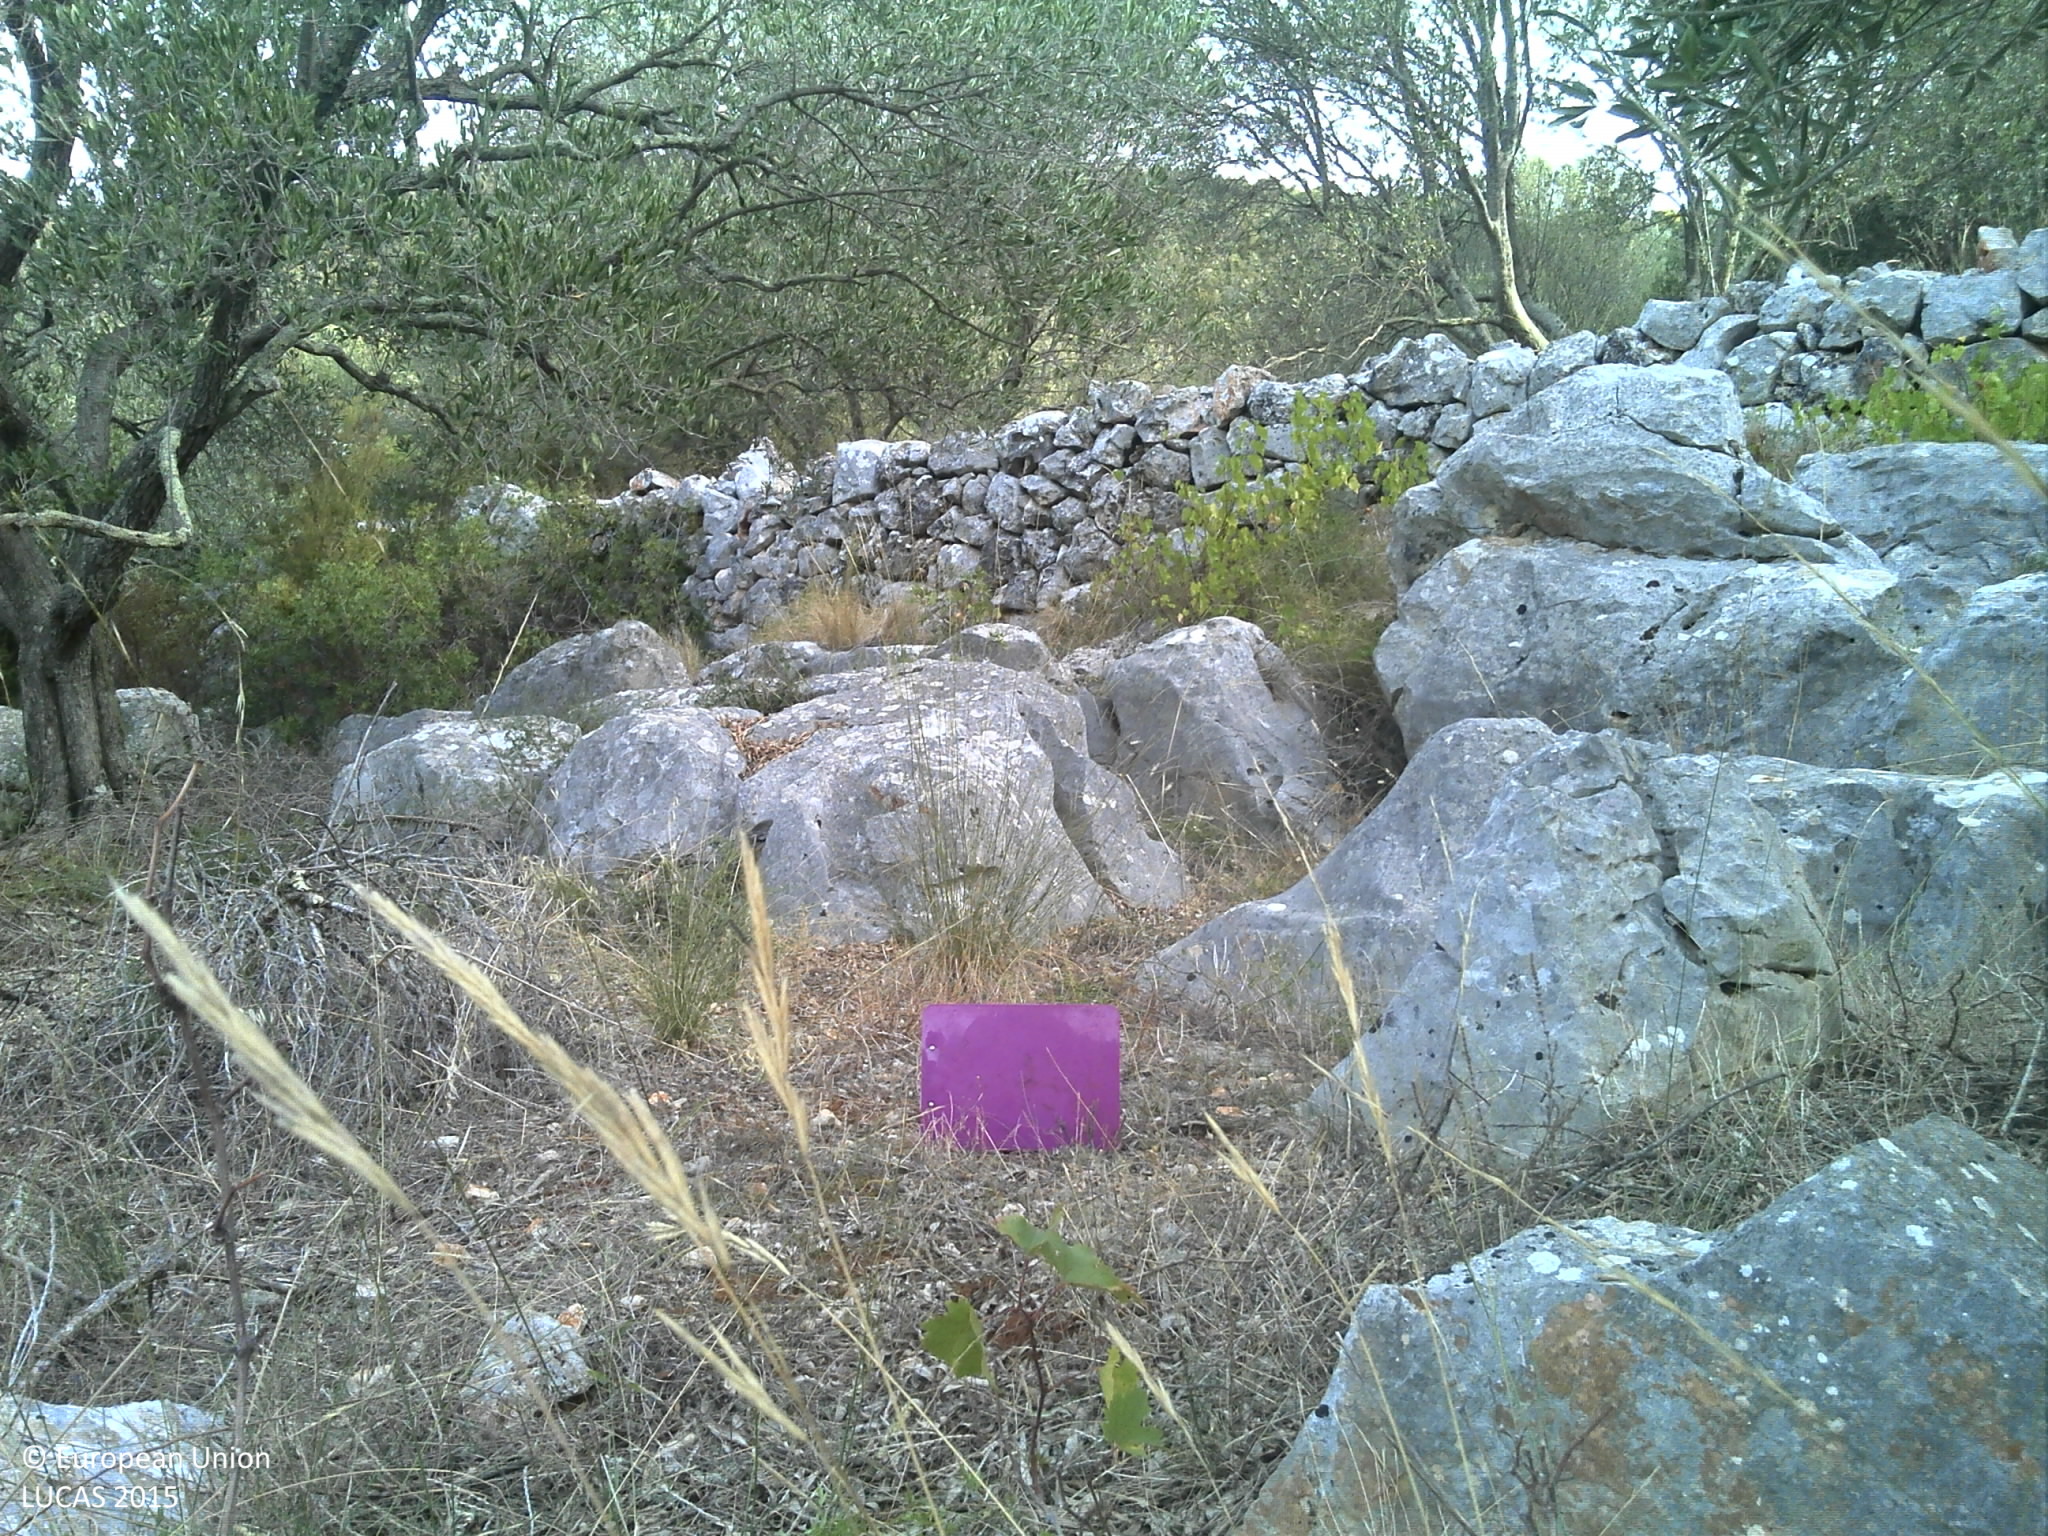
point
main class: Cropland
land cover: Olive groves
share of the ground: 25 - 50 %
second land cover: Rocks and stones
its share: > 75 %
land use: Agriculture (excluding fallow land and kitchen gardens)
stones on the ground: < 10 %
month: September
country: HR
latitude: 43.9535
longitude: 15.1130
